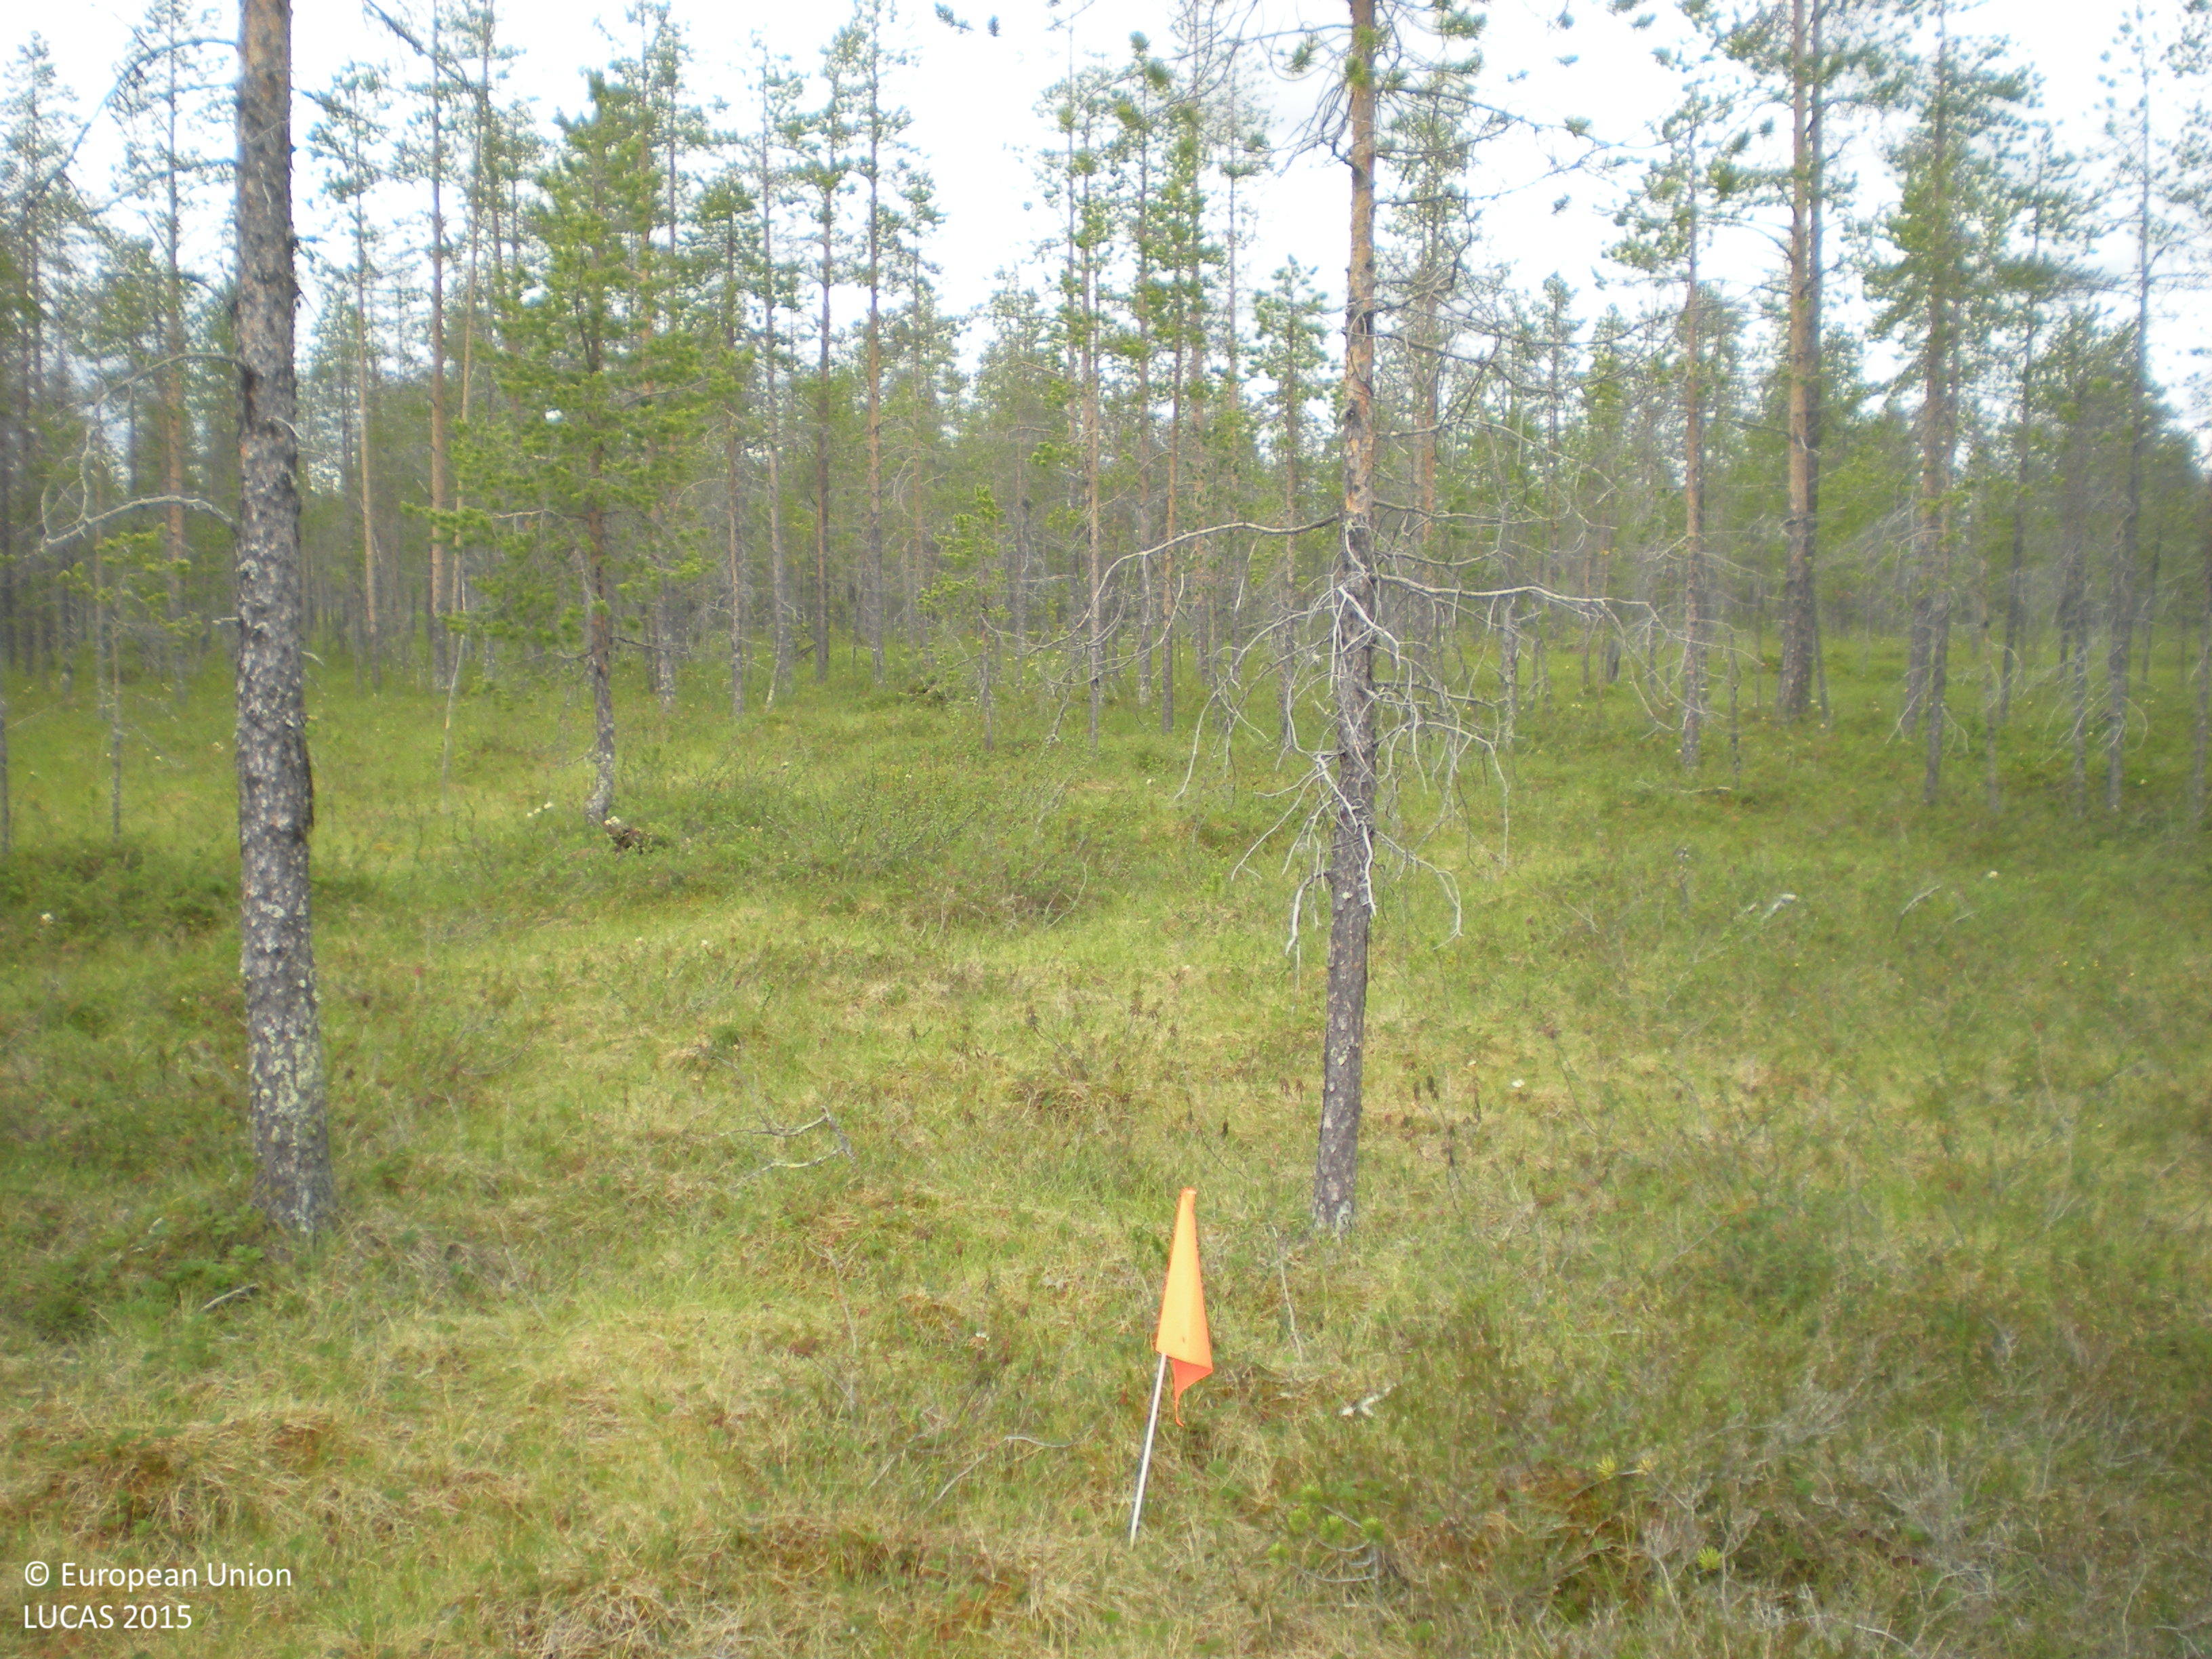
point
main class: Woodland
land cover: Pine dominated coniferous woodland
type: mire and swamp forests
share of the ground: 10 - 25 %
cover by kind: herbaceous plants 55 %, coniferous forest trees 20 %, shrubs 15 %, lichens and mosses 10 %
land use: Semi-natural and natural areas not in use
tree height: < 5 m
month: July
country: SE
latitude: 65.6429
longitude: 18.1508
